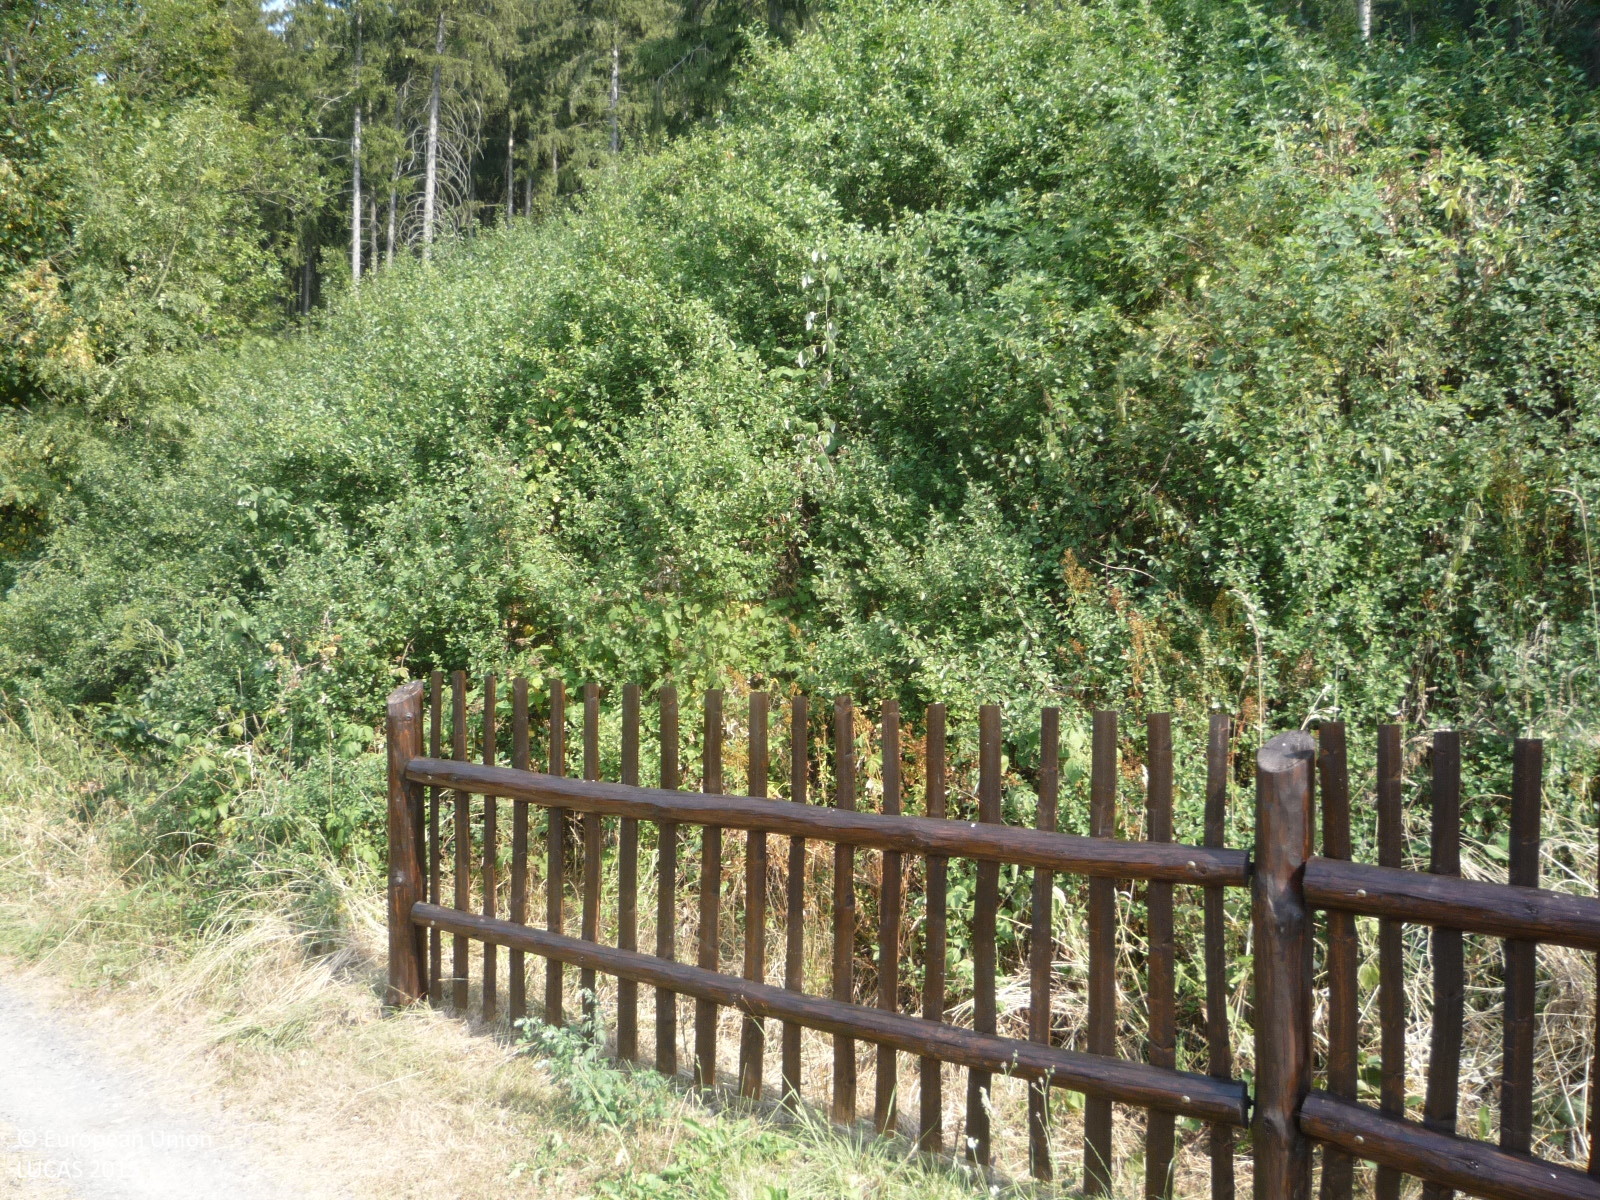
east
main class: Grassland
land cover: Spontaneously vegetated surfaces
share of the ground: > 75 %
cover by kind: herbaceous plants 100 %
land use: Semi-natural and natural areas not in use
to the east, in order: Tracks; Fences; Shrubland with sparse tree cover; Spruce dominated coniferous woodland; Tracks; Spruce dominated coniferous woodland
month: August
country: CZ
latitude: 49.9164
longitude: 14.4721
